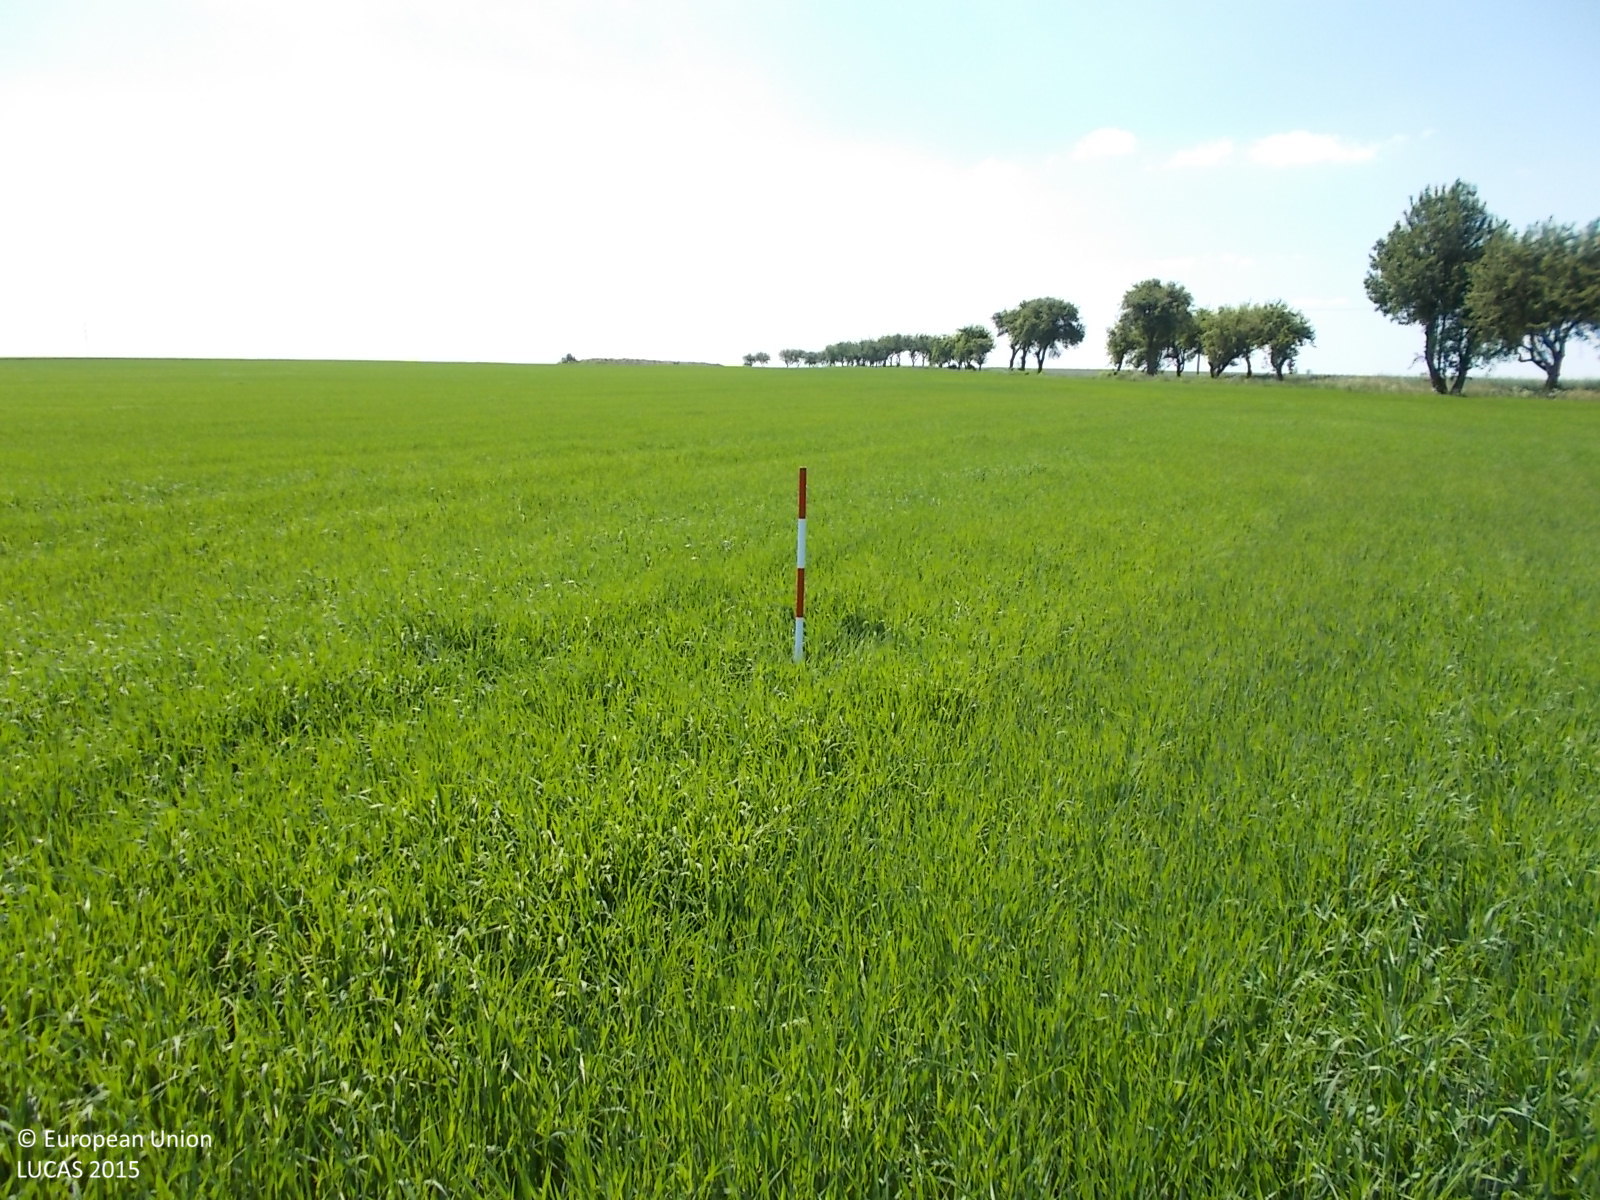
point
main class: Cropland
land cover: Barley
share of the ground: > 75 %
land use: Agriculture (excluding fallow land and kitchen gardens)
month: June
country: CZ
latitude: 49.9061
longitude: 15.1409
